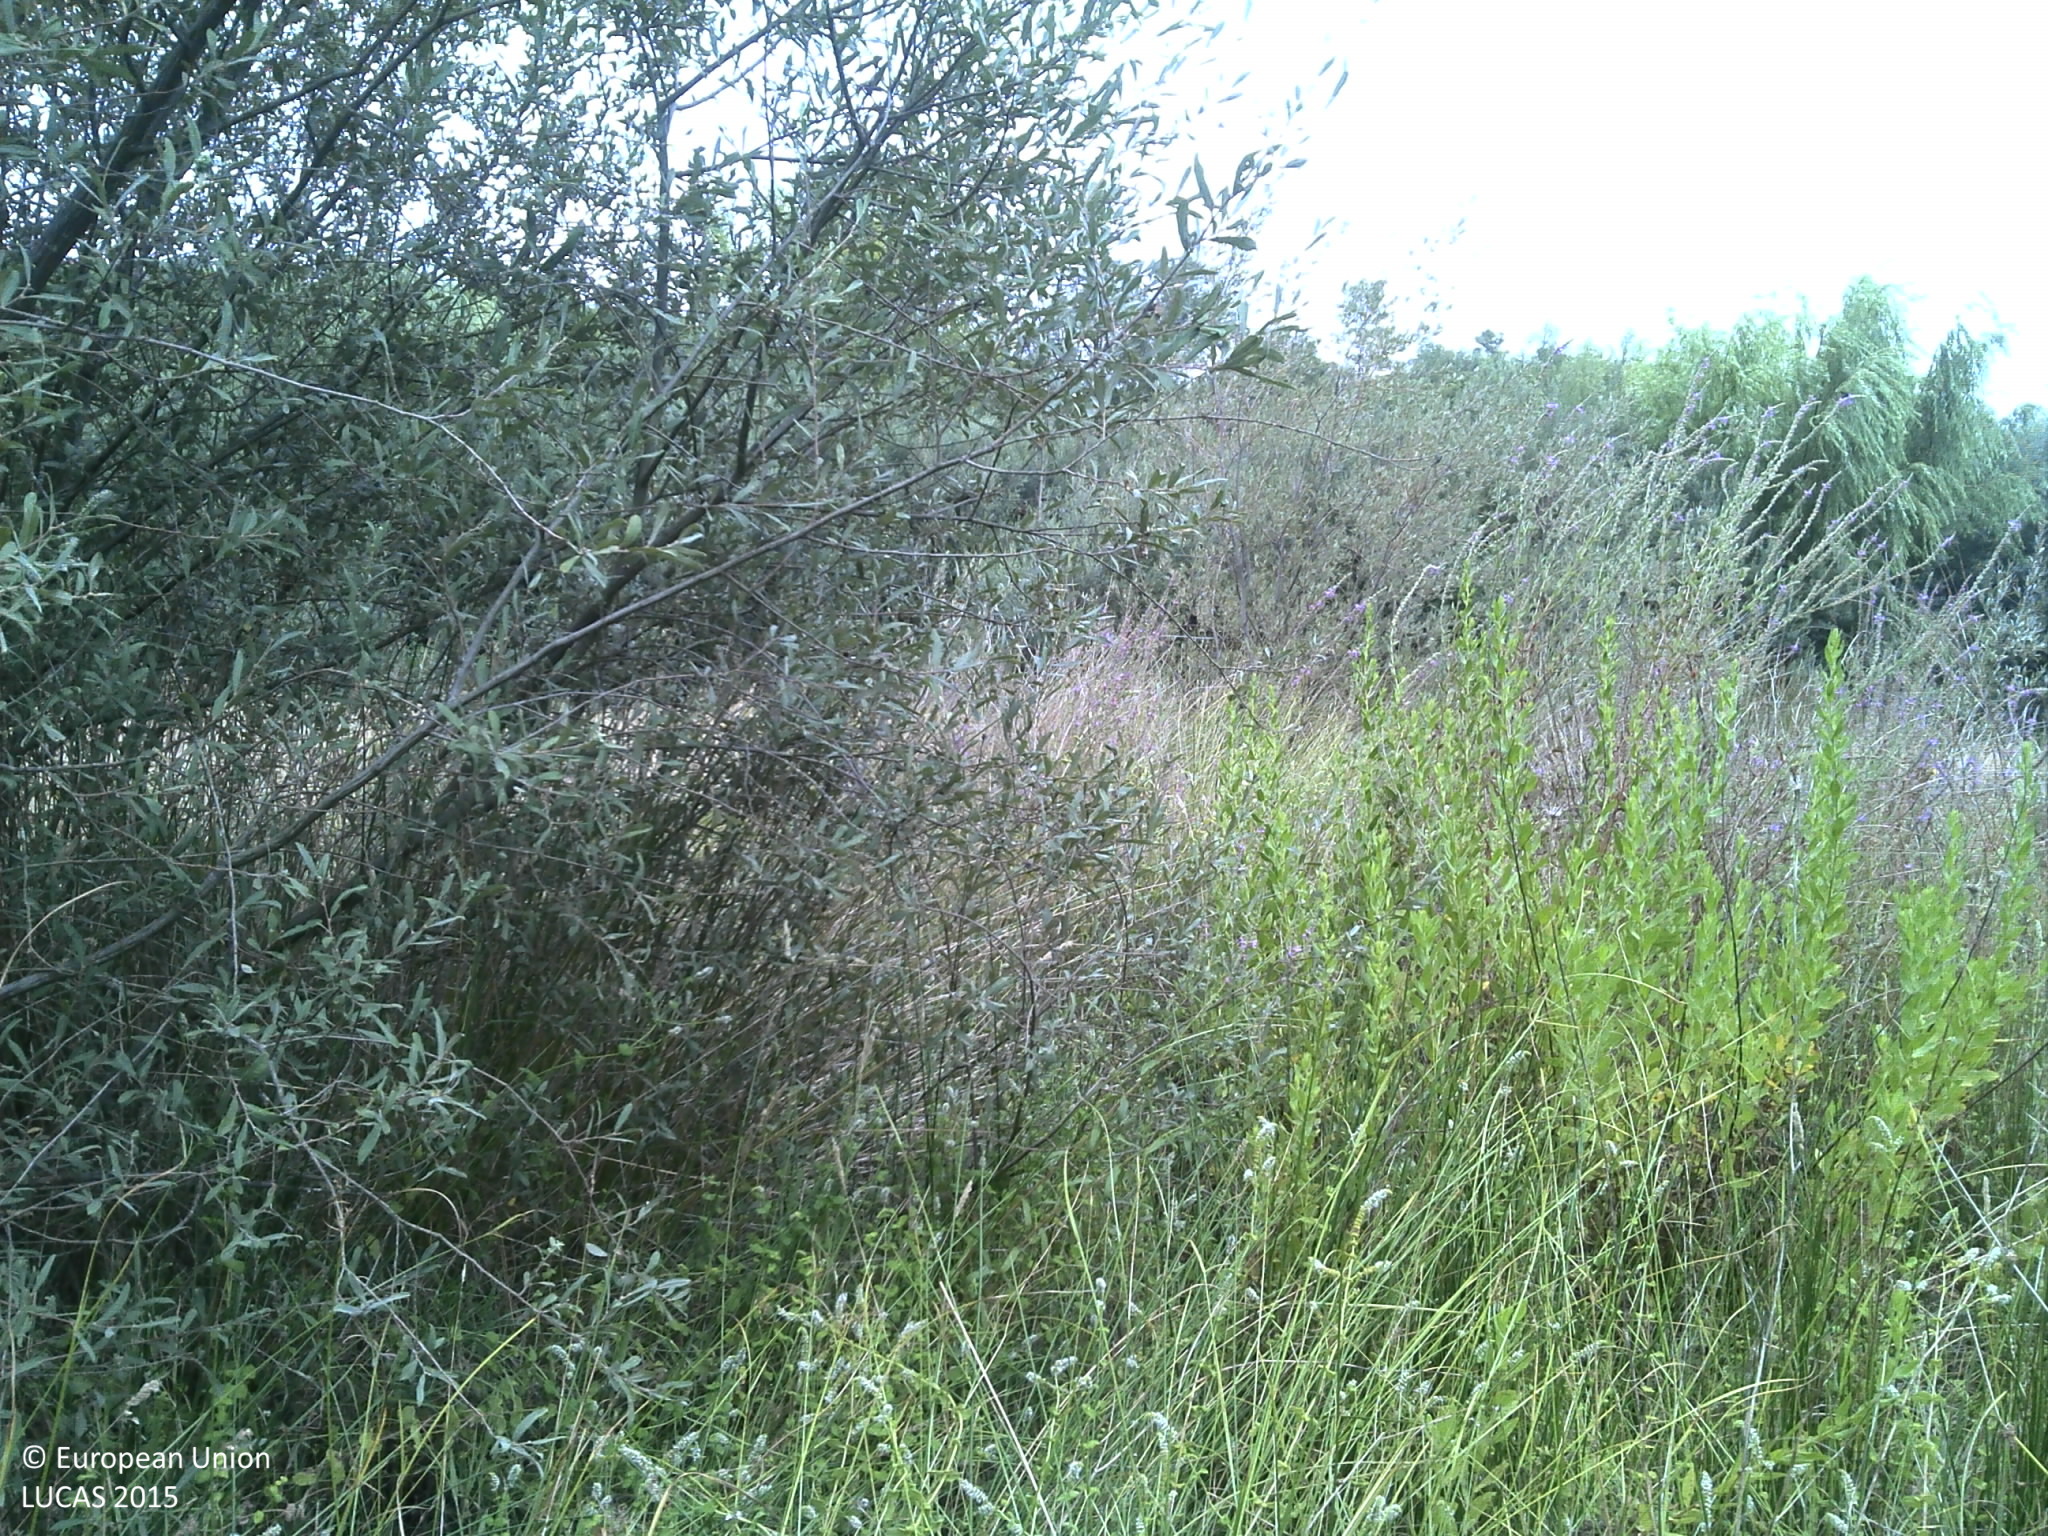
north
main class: Shrubland
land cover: Shrubland with sparse tree cover
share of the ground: > 75 %
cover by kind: shrubs 85 %, unconsolidated bare surface 10 %, broadleaved forest trees 5 %
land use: Abandoned areas
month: August
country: PT
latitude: 38.8933
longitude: -8.2357
